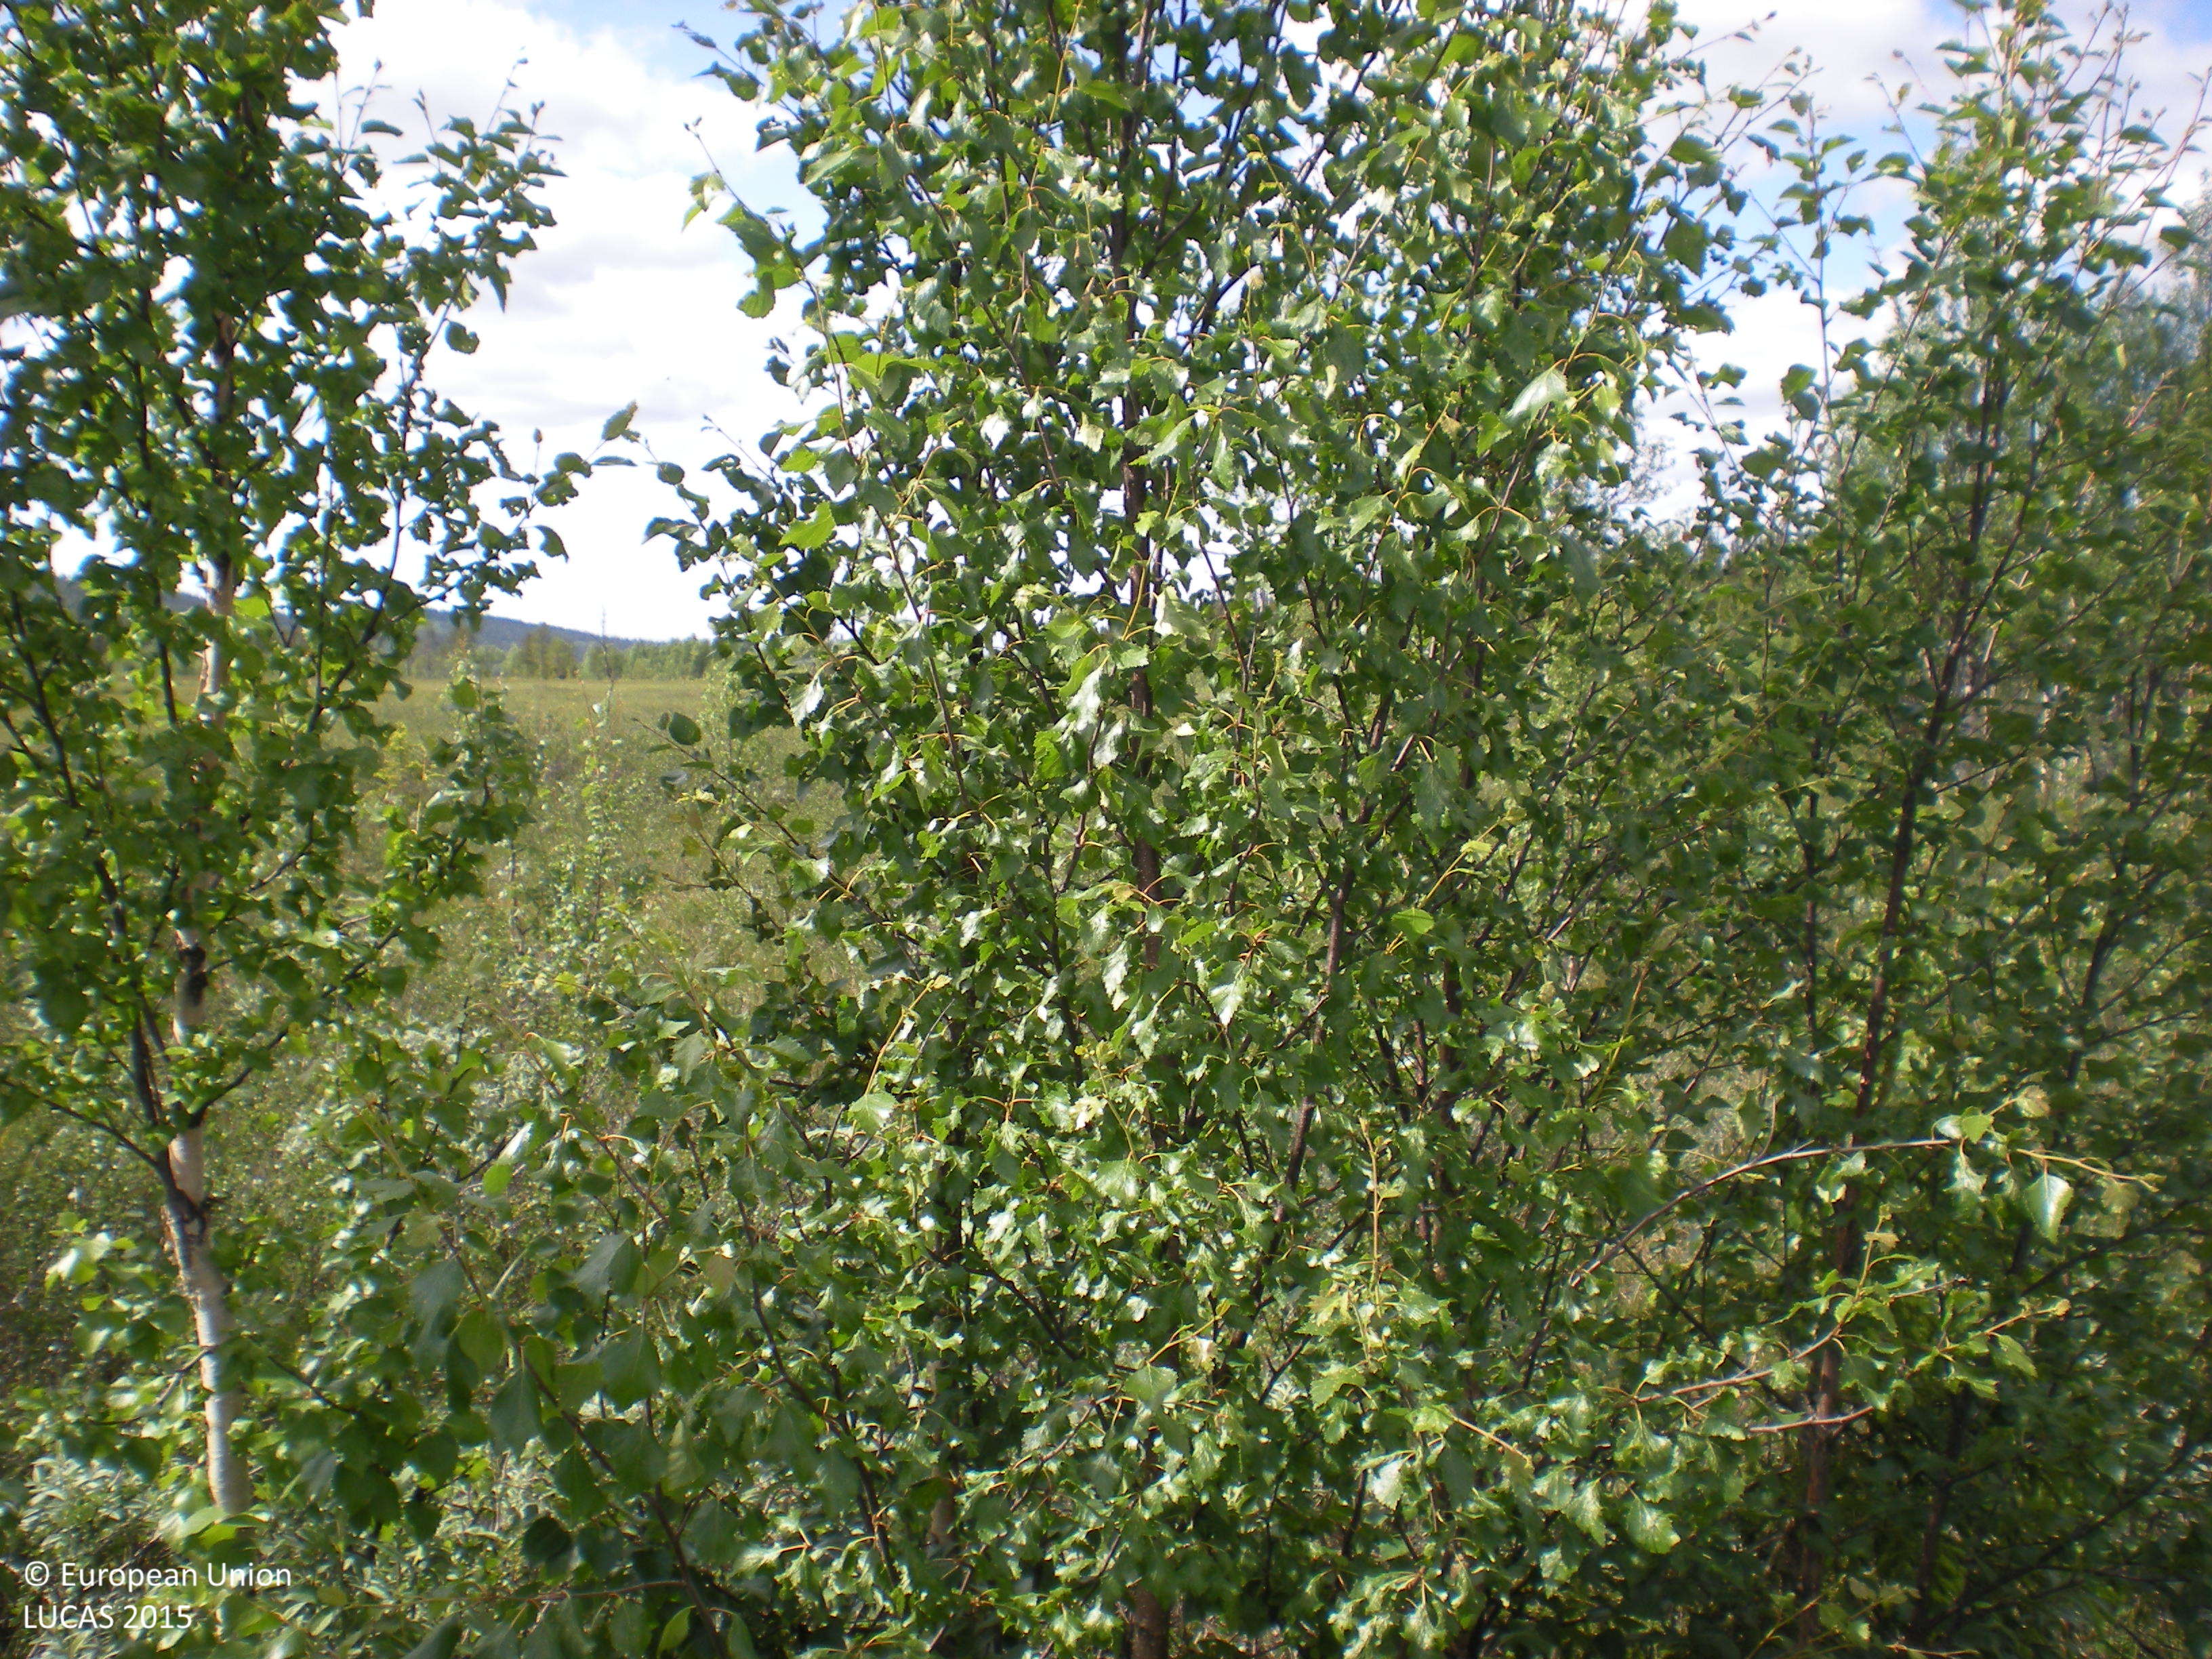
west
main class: Woodland
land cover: Broadleaved woodland
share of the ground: 10 - 25 %
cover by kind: herbaceous plants 70 %, broadleaved forest trees 30 %
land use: Semi-natural and natural areas not in use
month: July
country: SE
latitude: 65.4660
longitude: 16.8460
